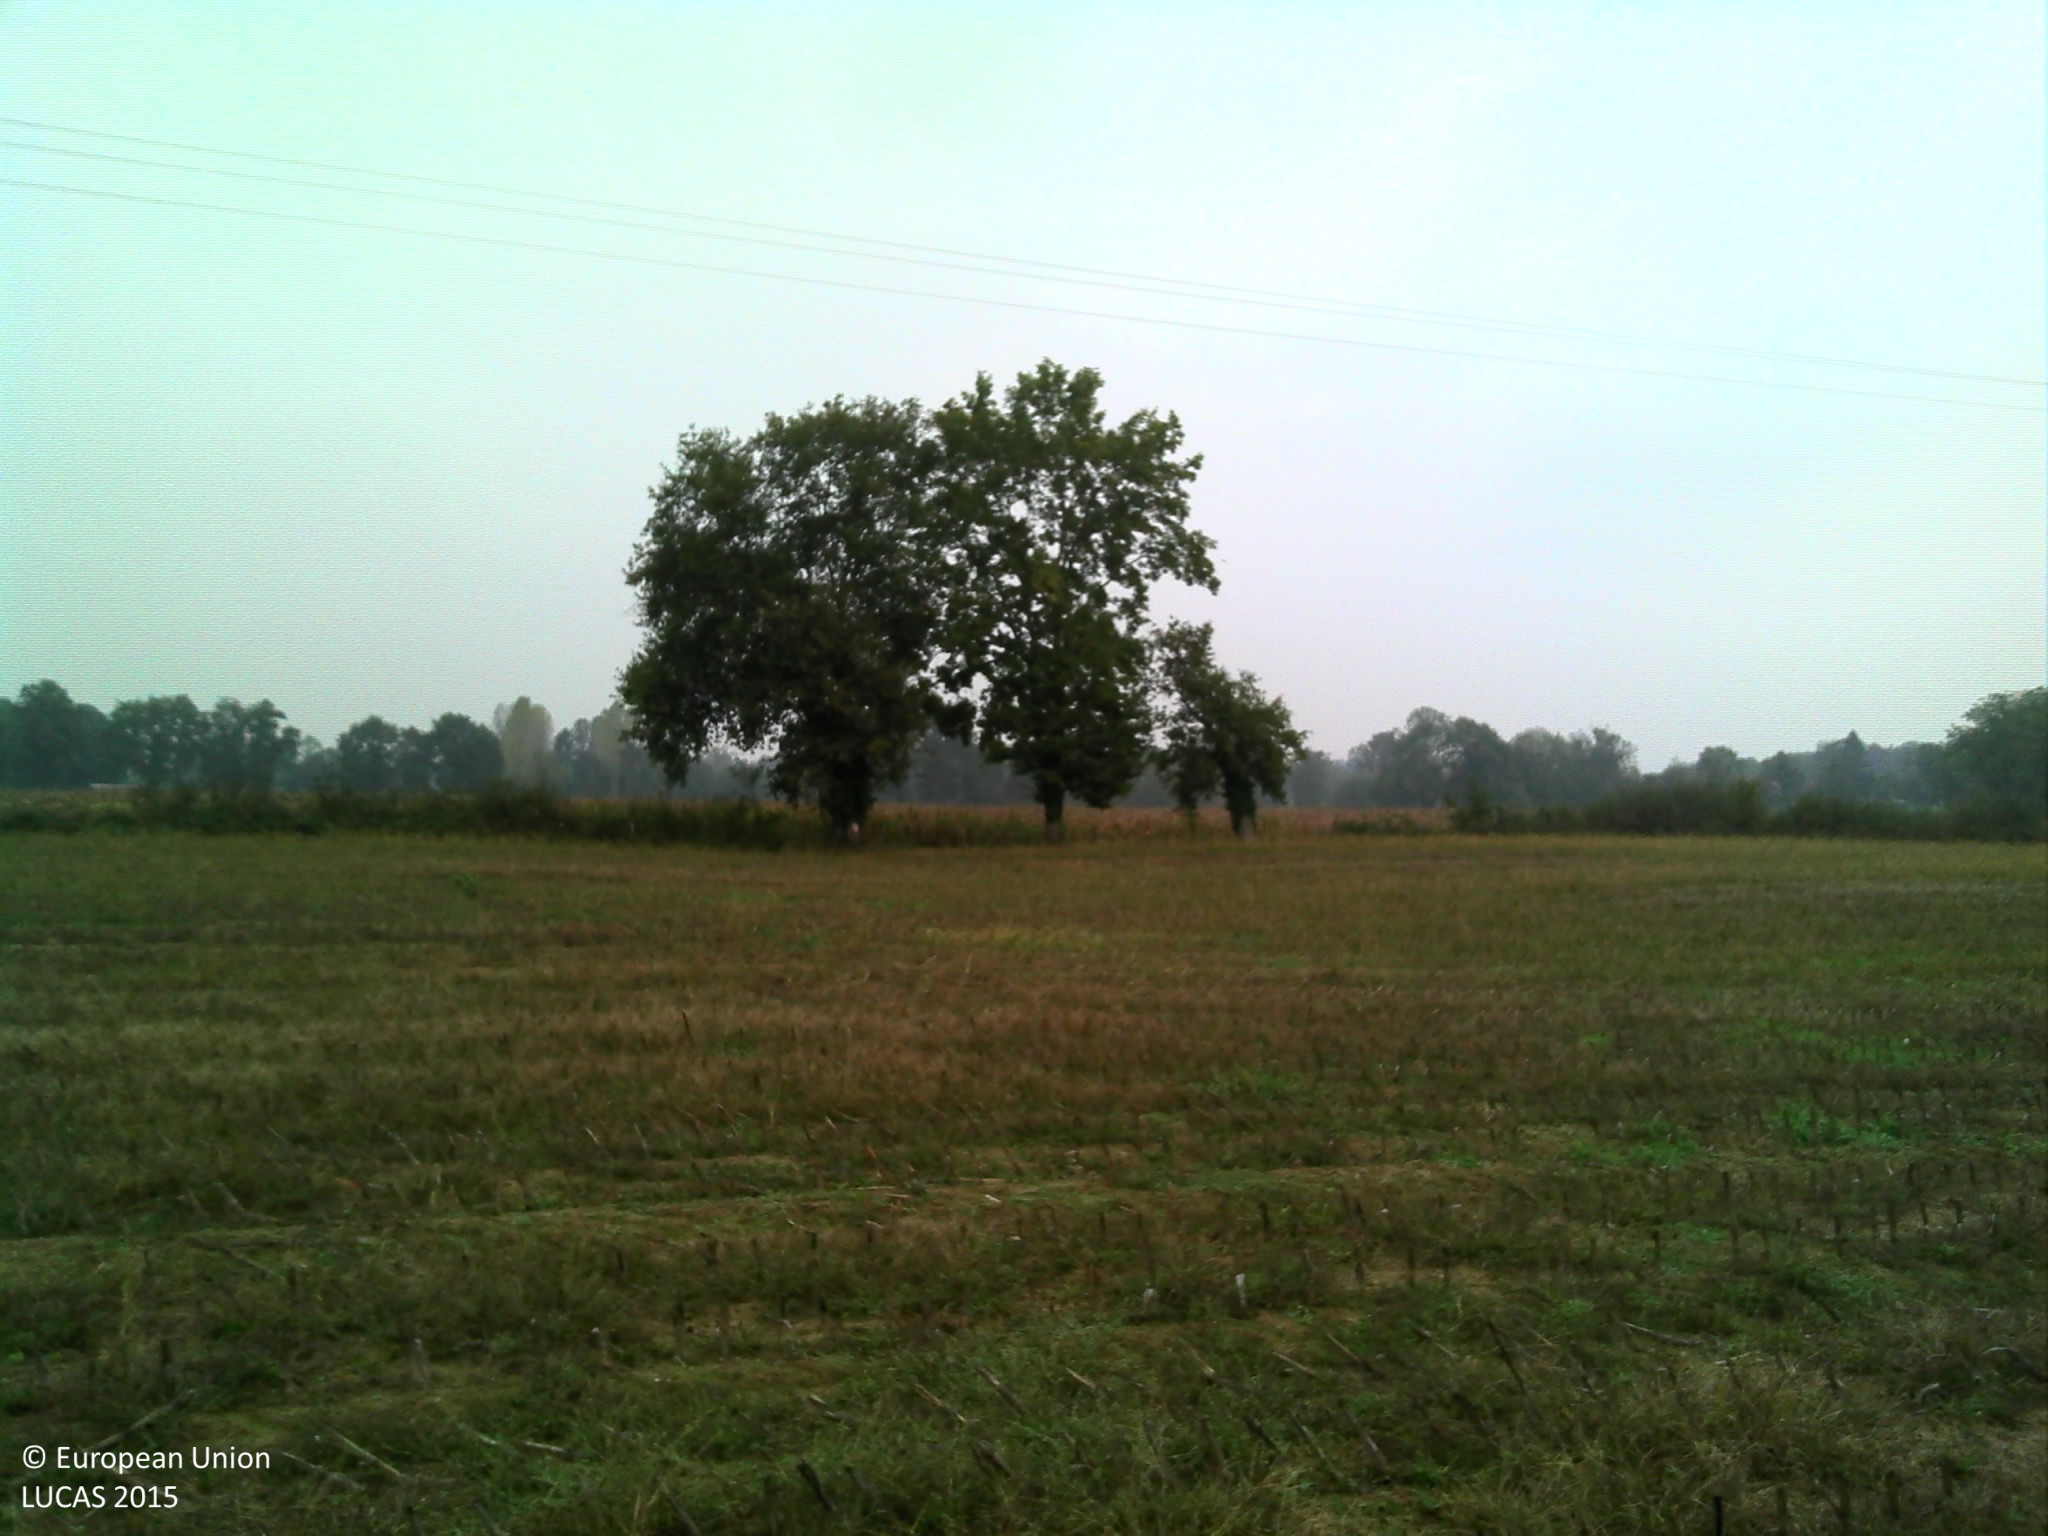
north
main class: Cropland
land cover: Maize
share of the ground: < 10 %
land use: Agriculture (excluding fallow land and kitchen gardens)
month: October
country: FR
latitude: 46.2947
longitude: 5.1346
